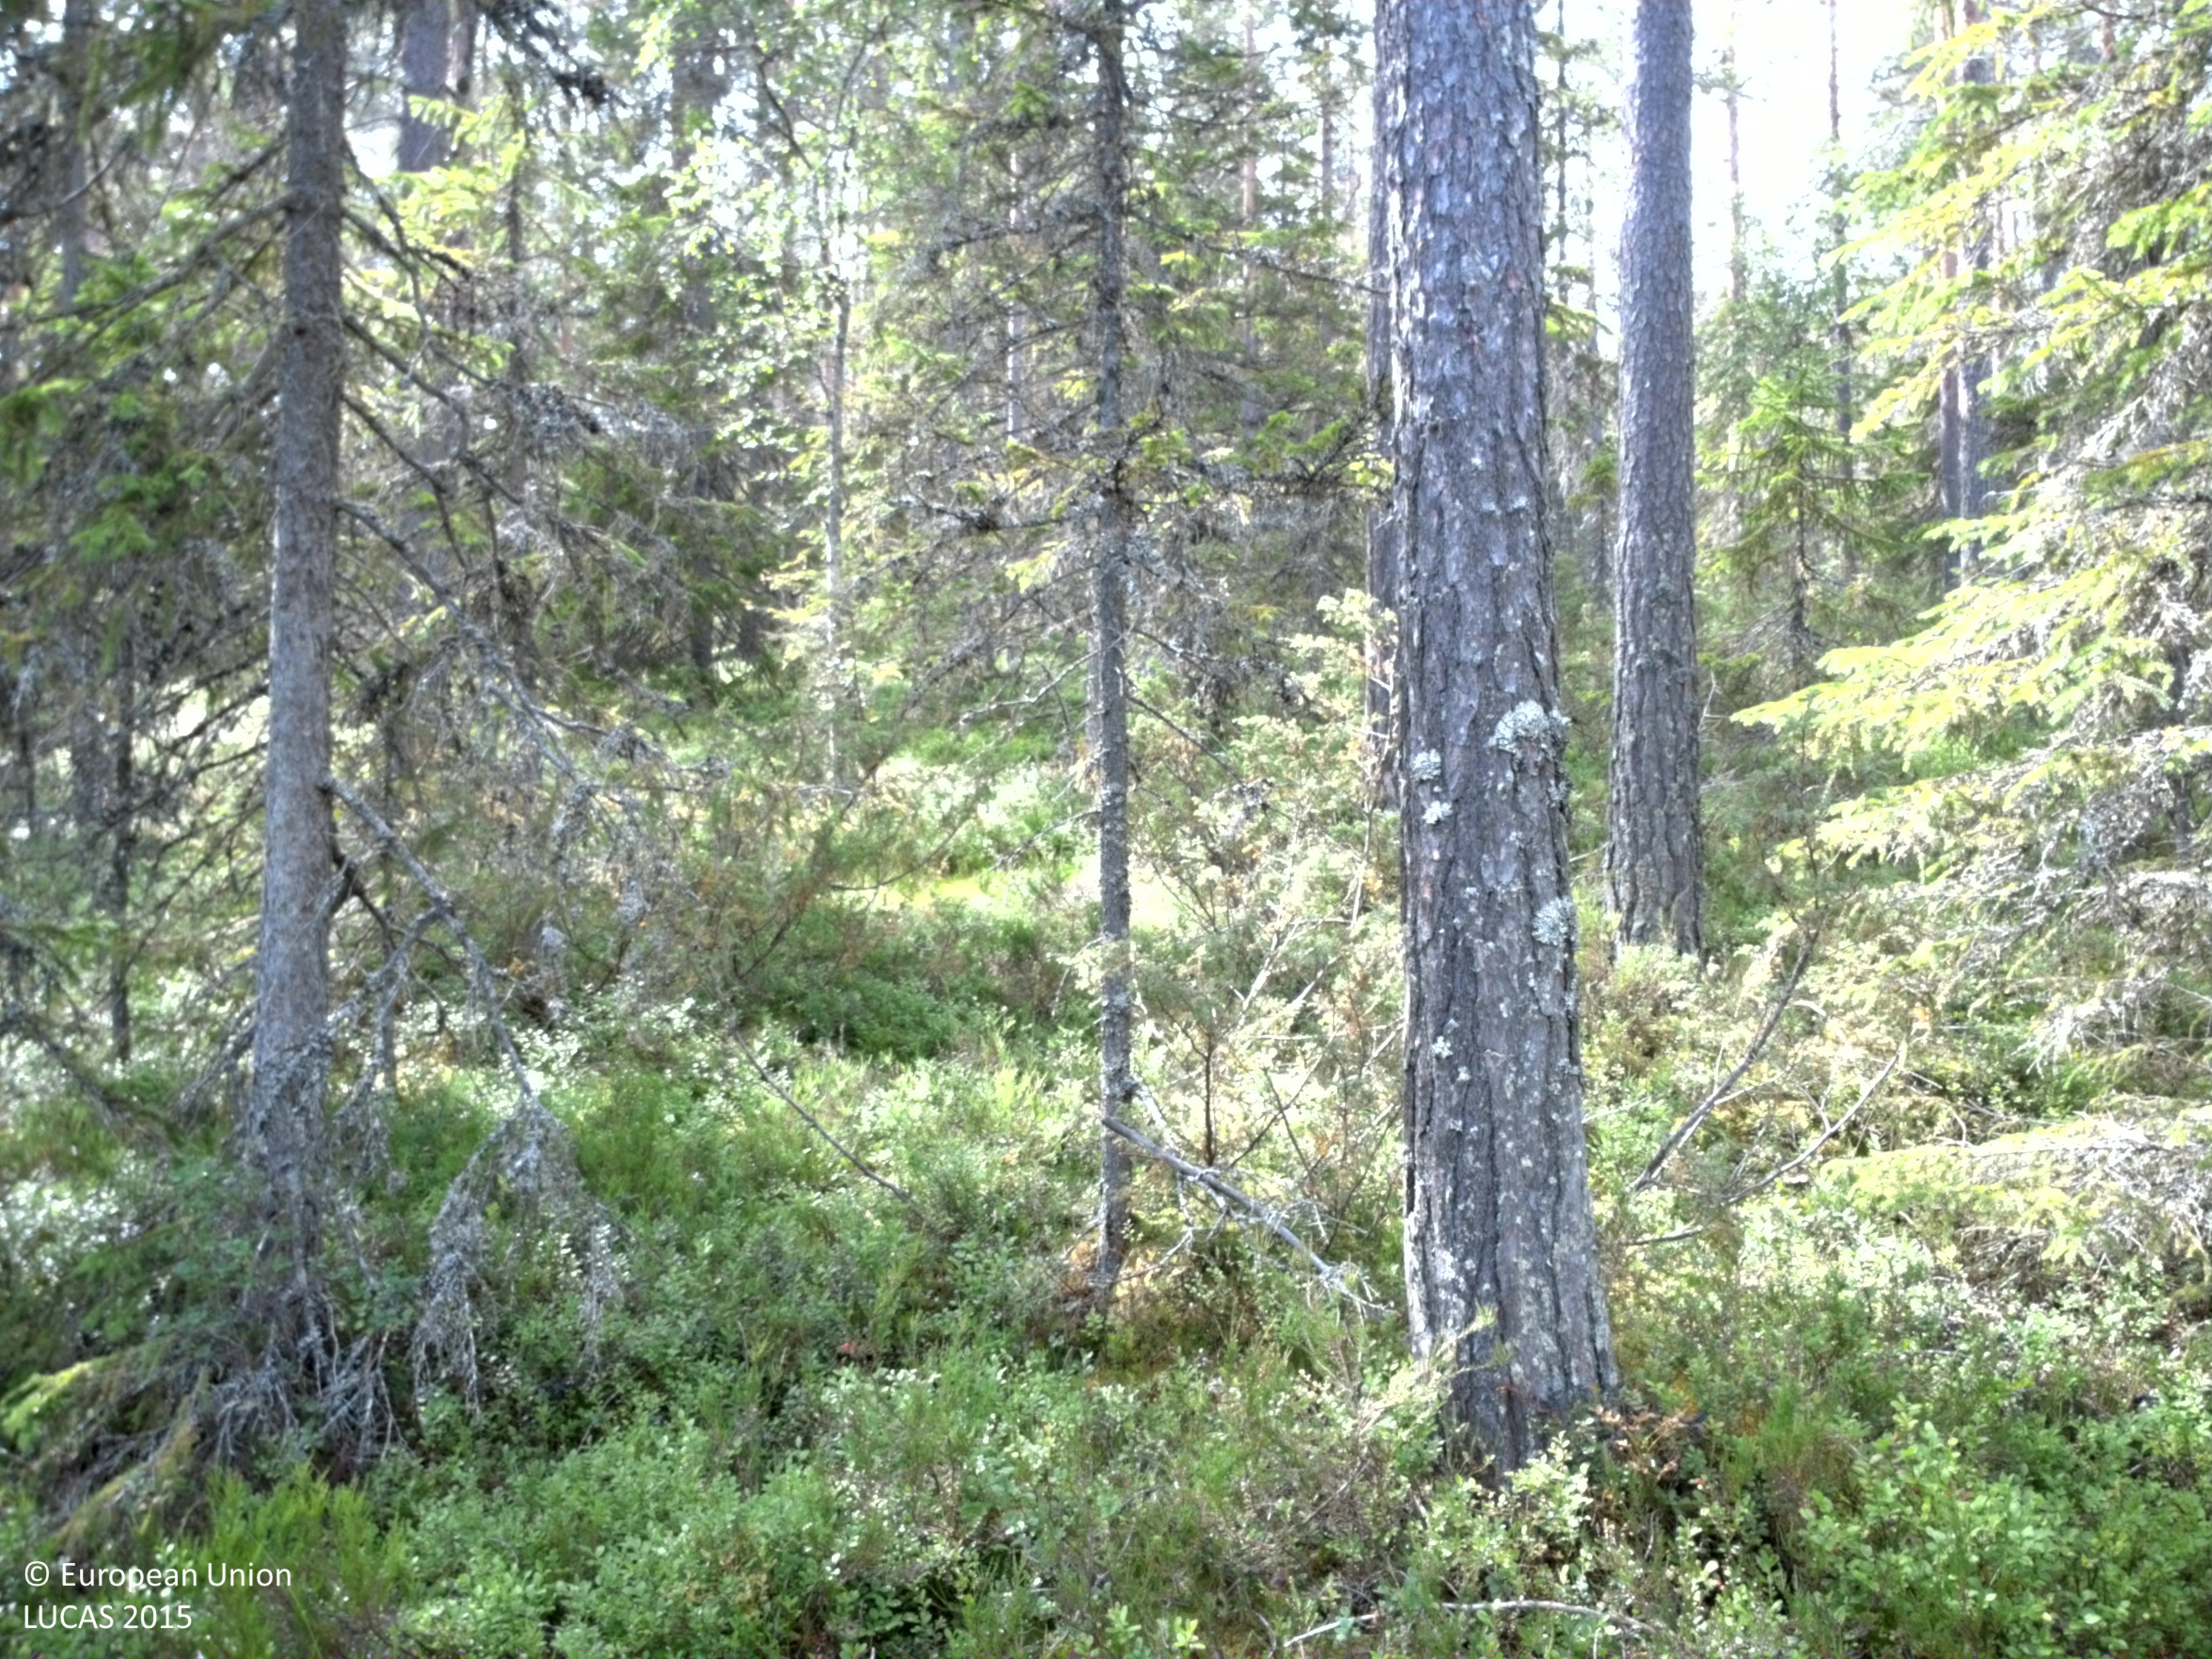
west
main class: Woodland
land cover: Other coniferous woodland
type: boreal forest
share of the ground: 50 - 75 %
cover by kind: coniferous forest trees 65 %, lichens and mosses 25 %, herbaceous plants 10 %
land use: Forestry
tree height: > 5 m
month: July
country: SE
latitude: 61.4326
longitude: 13.6052
